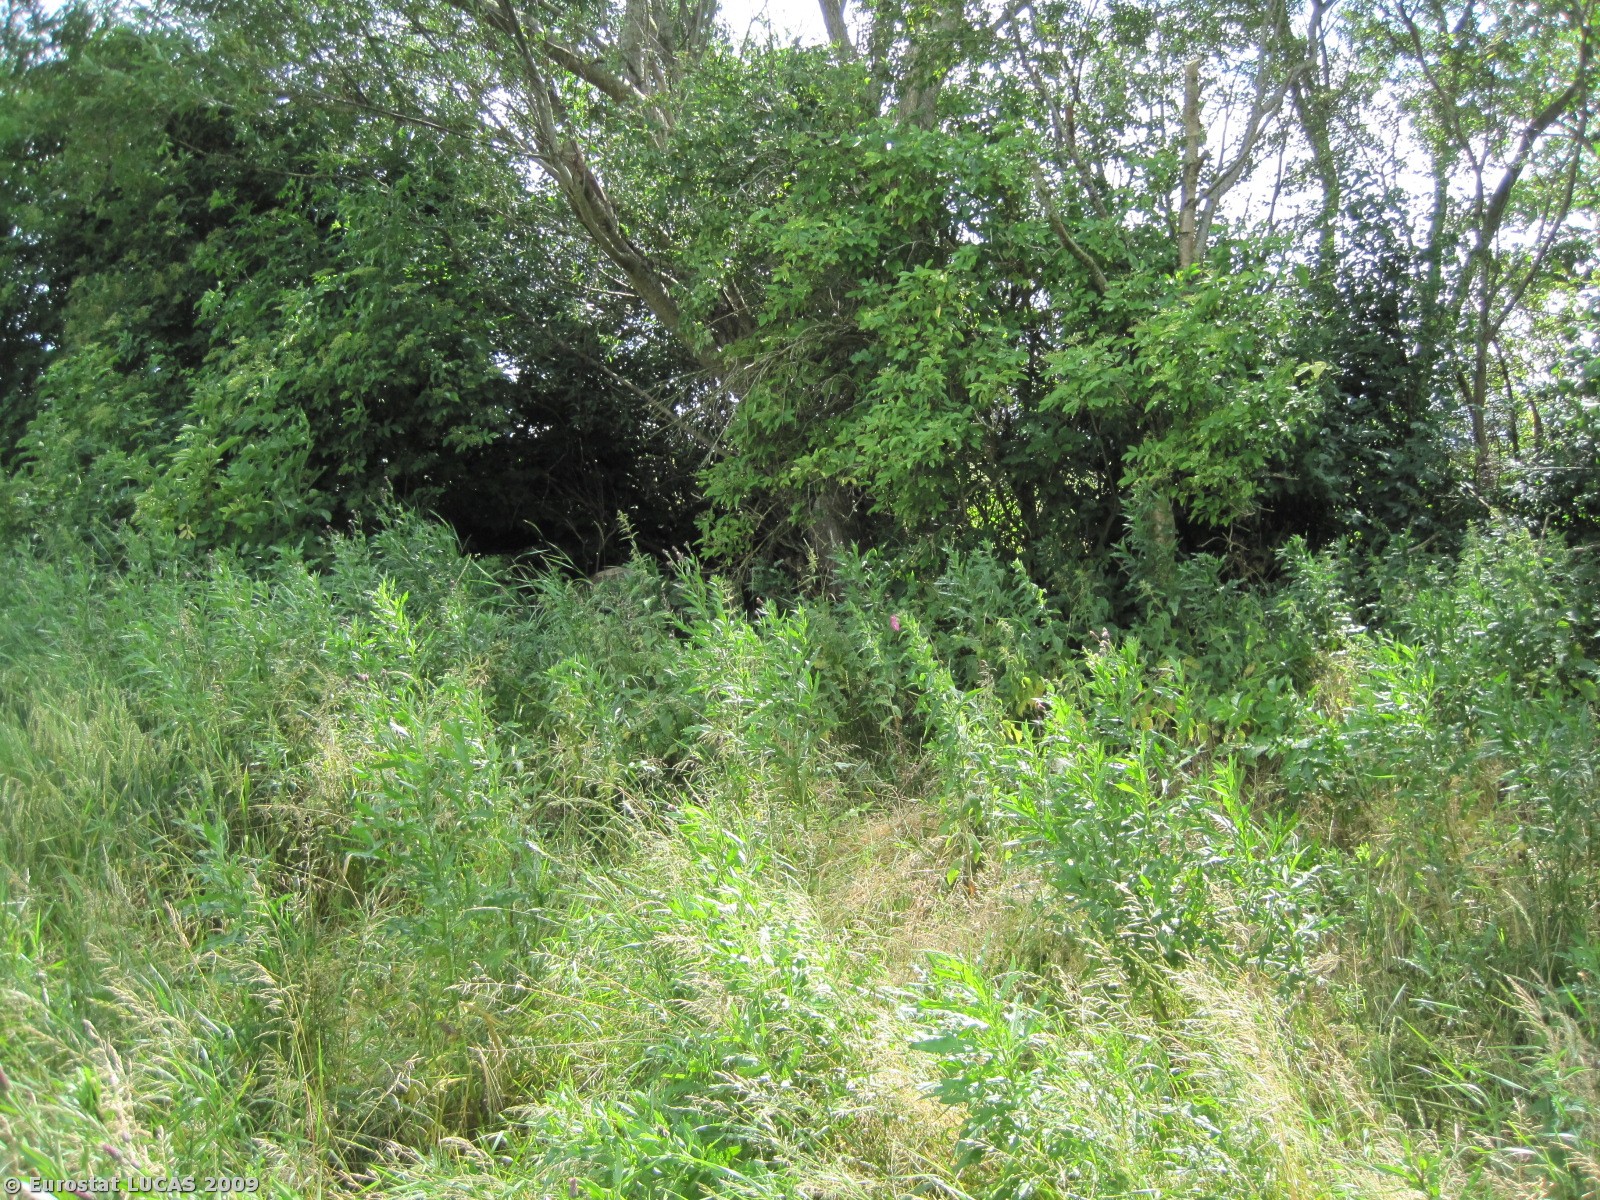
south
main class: Woodland
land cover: Broadleaved woodland
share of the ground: > 75 %
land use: Forestry
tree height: > 5 m
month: July
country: DK
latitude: 57.0269
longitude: 8.7662
